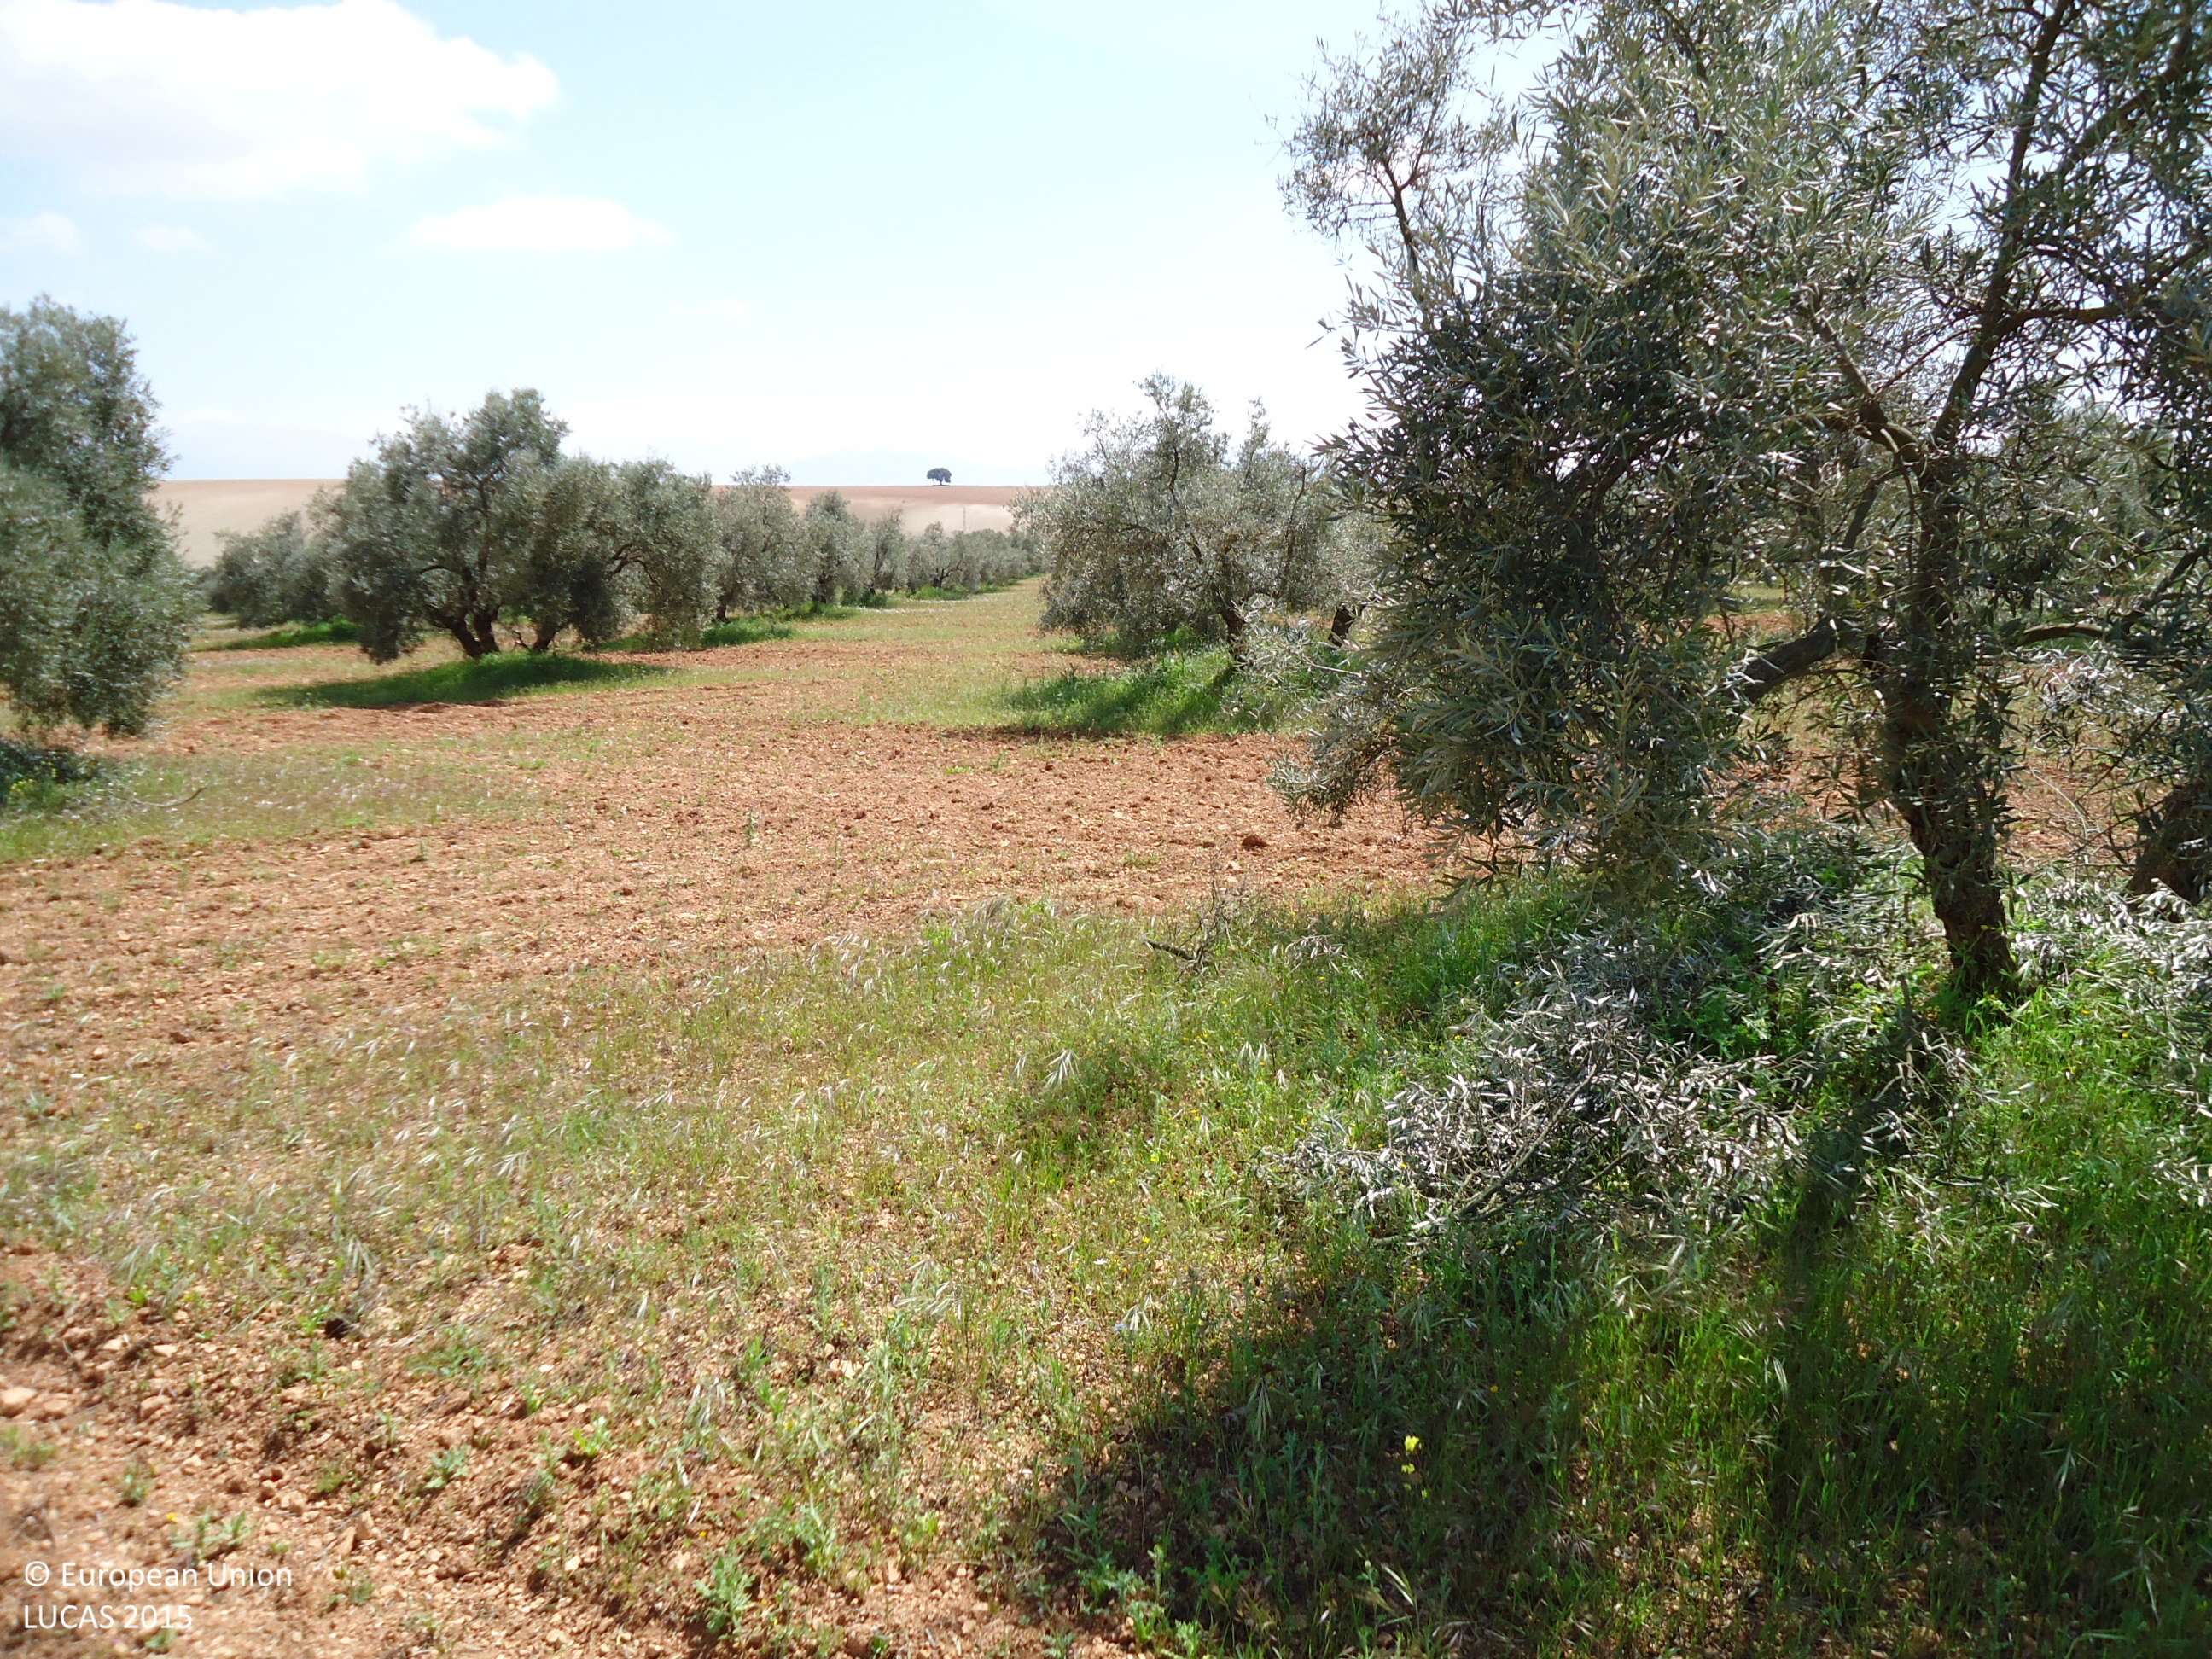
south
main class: Cropland
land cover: Olive groves
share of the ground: 10 - 25 %
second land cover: Spontaneously vegetated surfaces
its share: > 75 %
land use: Agriculture (excluding fallow land and kitchen gardens)
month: April
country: ES
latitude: 37.0770
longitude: -4.8149
